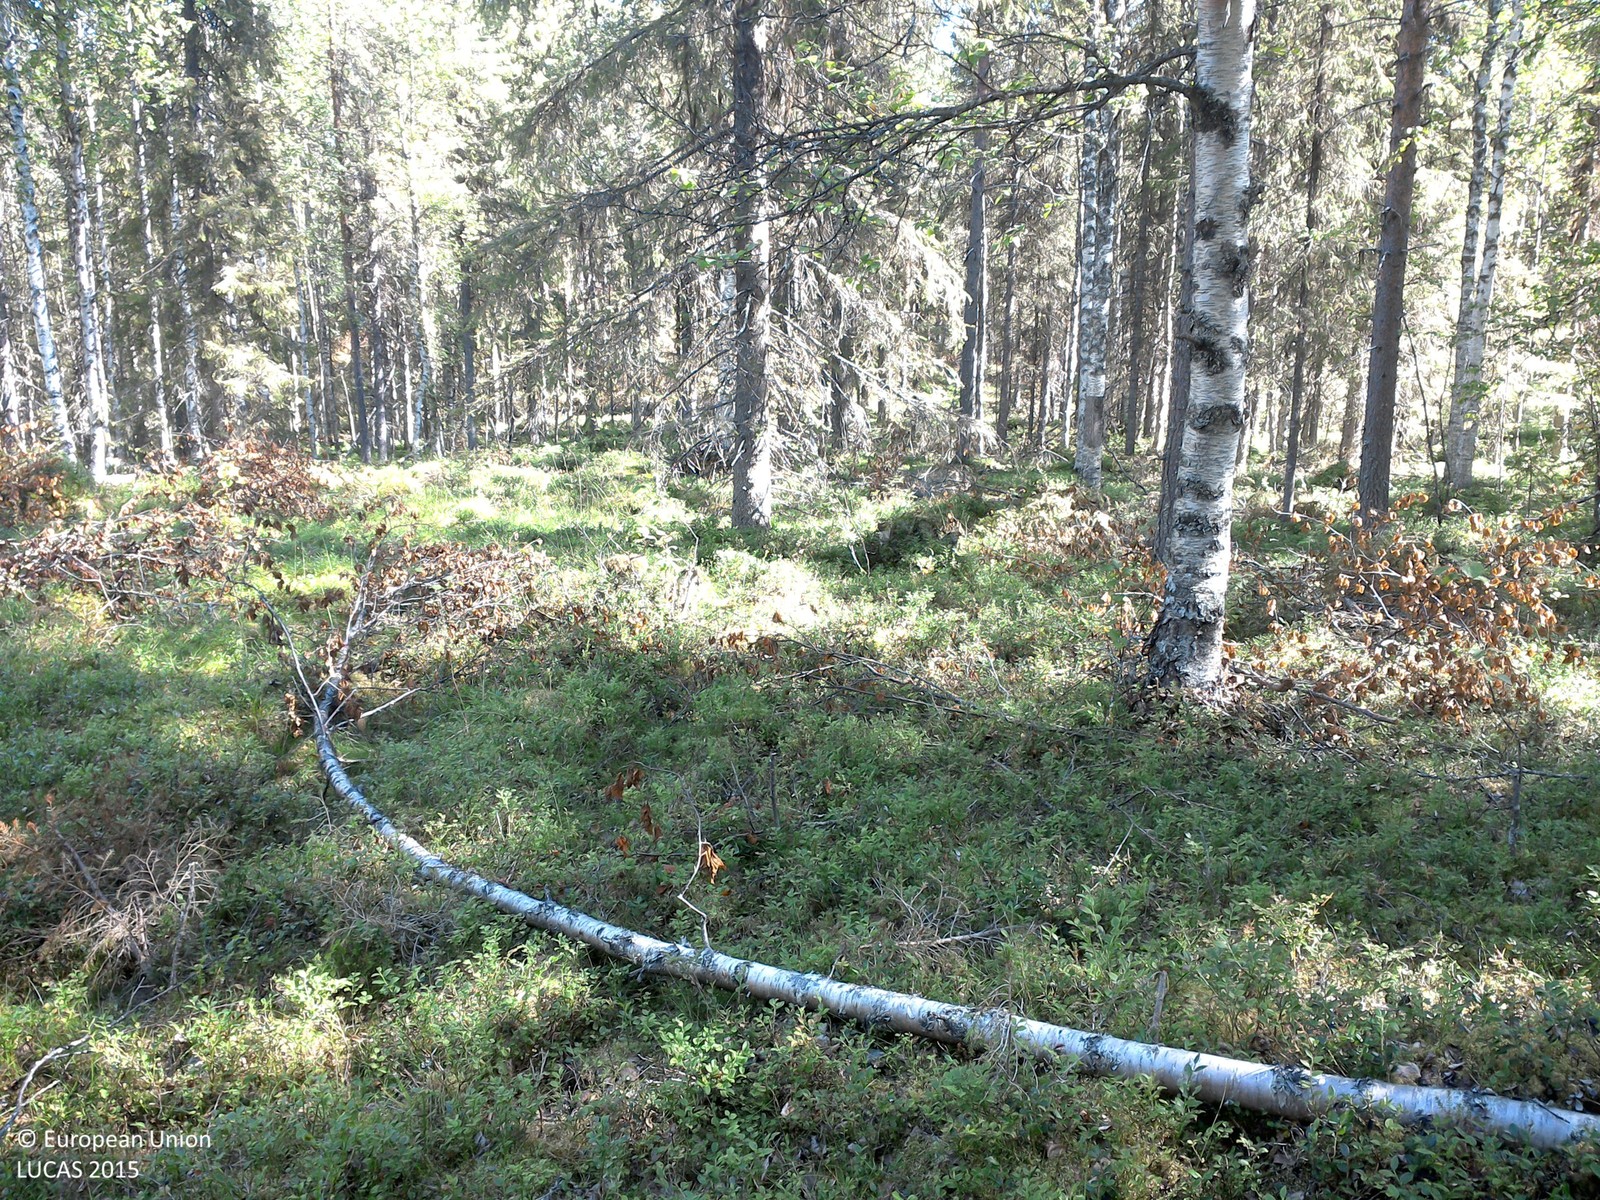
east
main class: Woodland
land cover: Spruce dominated mixed woodland
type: boreal forest
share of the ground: 25 - 50 %
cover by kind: shrubs 60 %, coniferous forest trees 20 %, broadleaved forest trees 15 %, lichens and mosses 5 %
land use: Forestry
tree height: > 5 m
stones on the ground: > 50 %
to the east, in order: Spruce dominated mixed woodland; Rivers and streams; Spruce dominated mixed woodland; Pine dominated coniferous woodland; Spruce dominated mixed woodland; Pine dominated mixed woodland; Sand; Groves; Sand; Groves; Paved roads, cycling and walking lanes; Groves; Spruce dominated mixed woodland; Ditches and canals; Spruce dominated mixed woodland
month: August
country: SE
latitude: 67.1349
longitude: 21.4159
